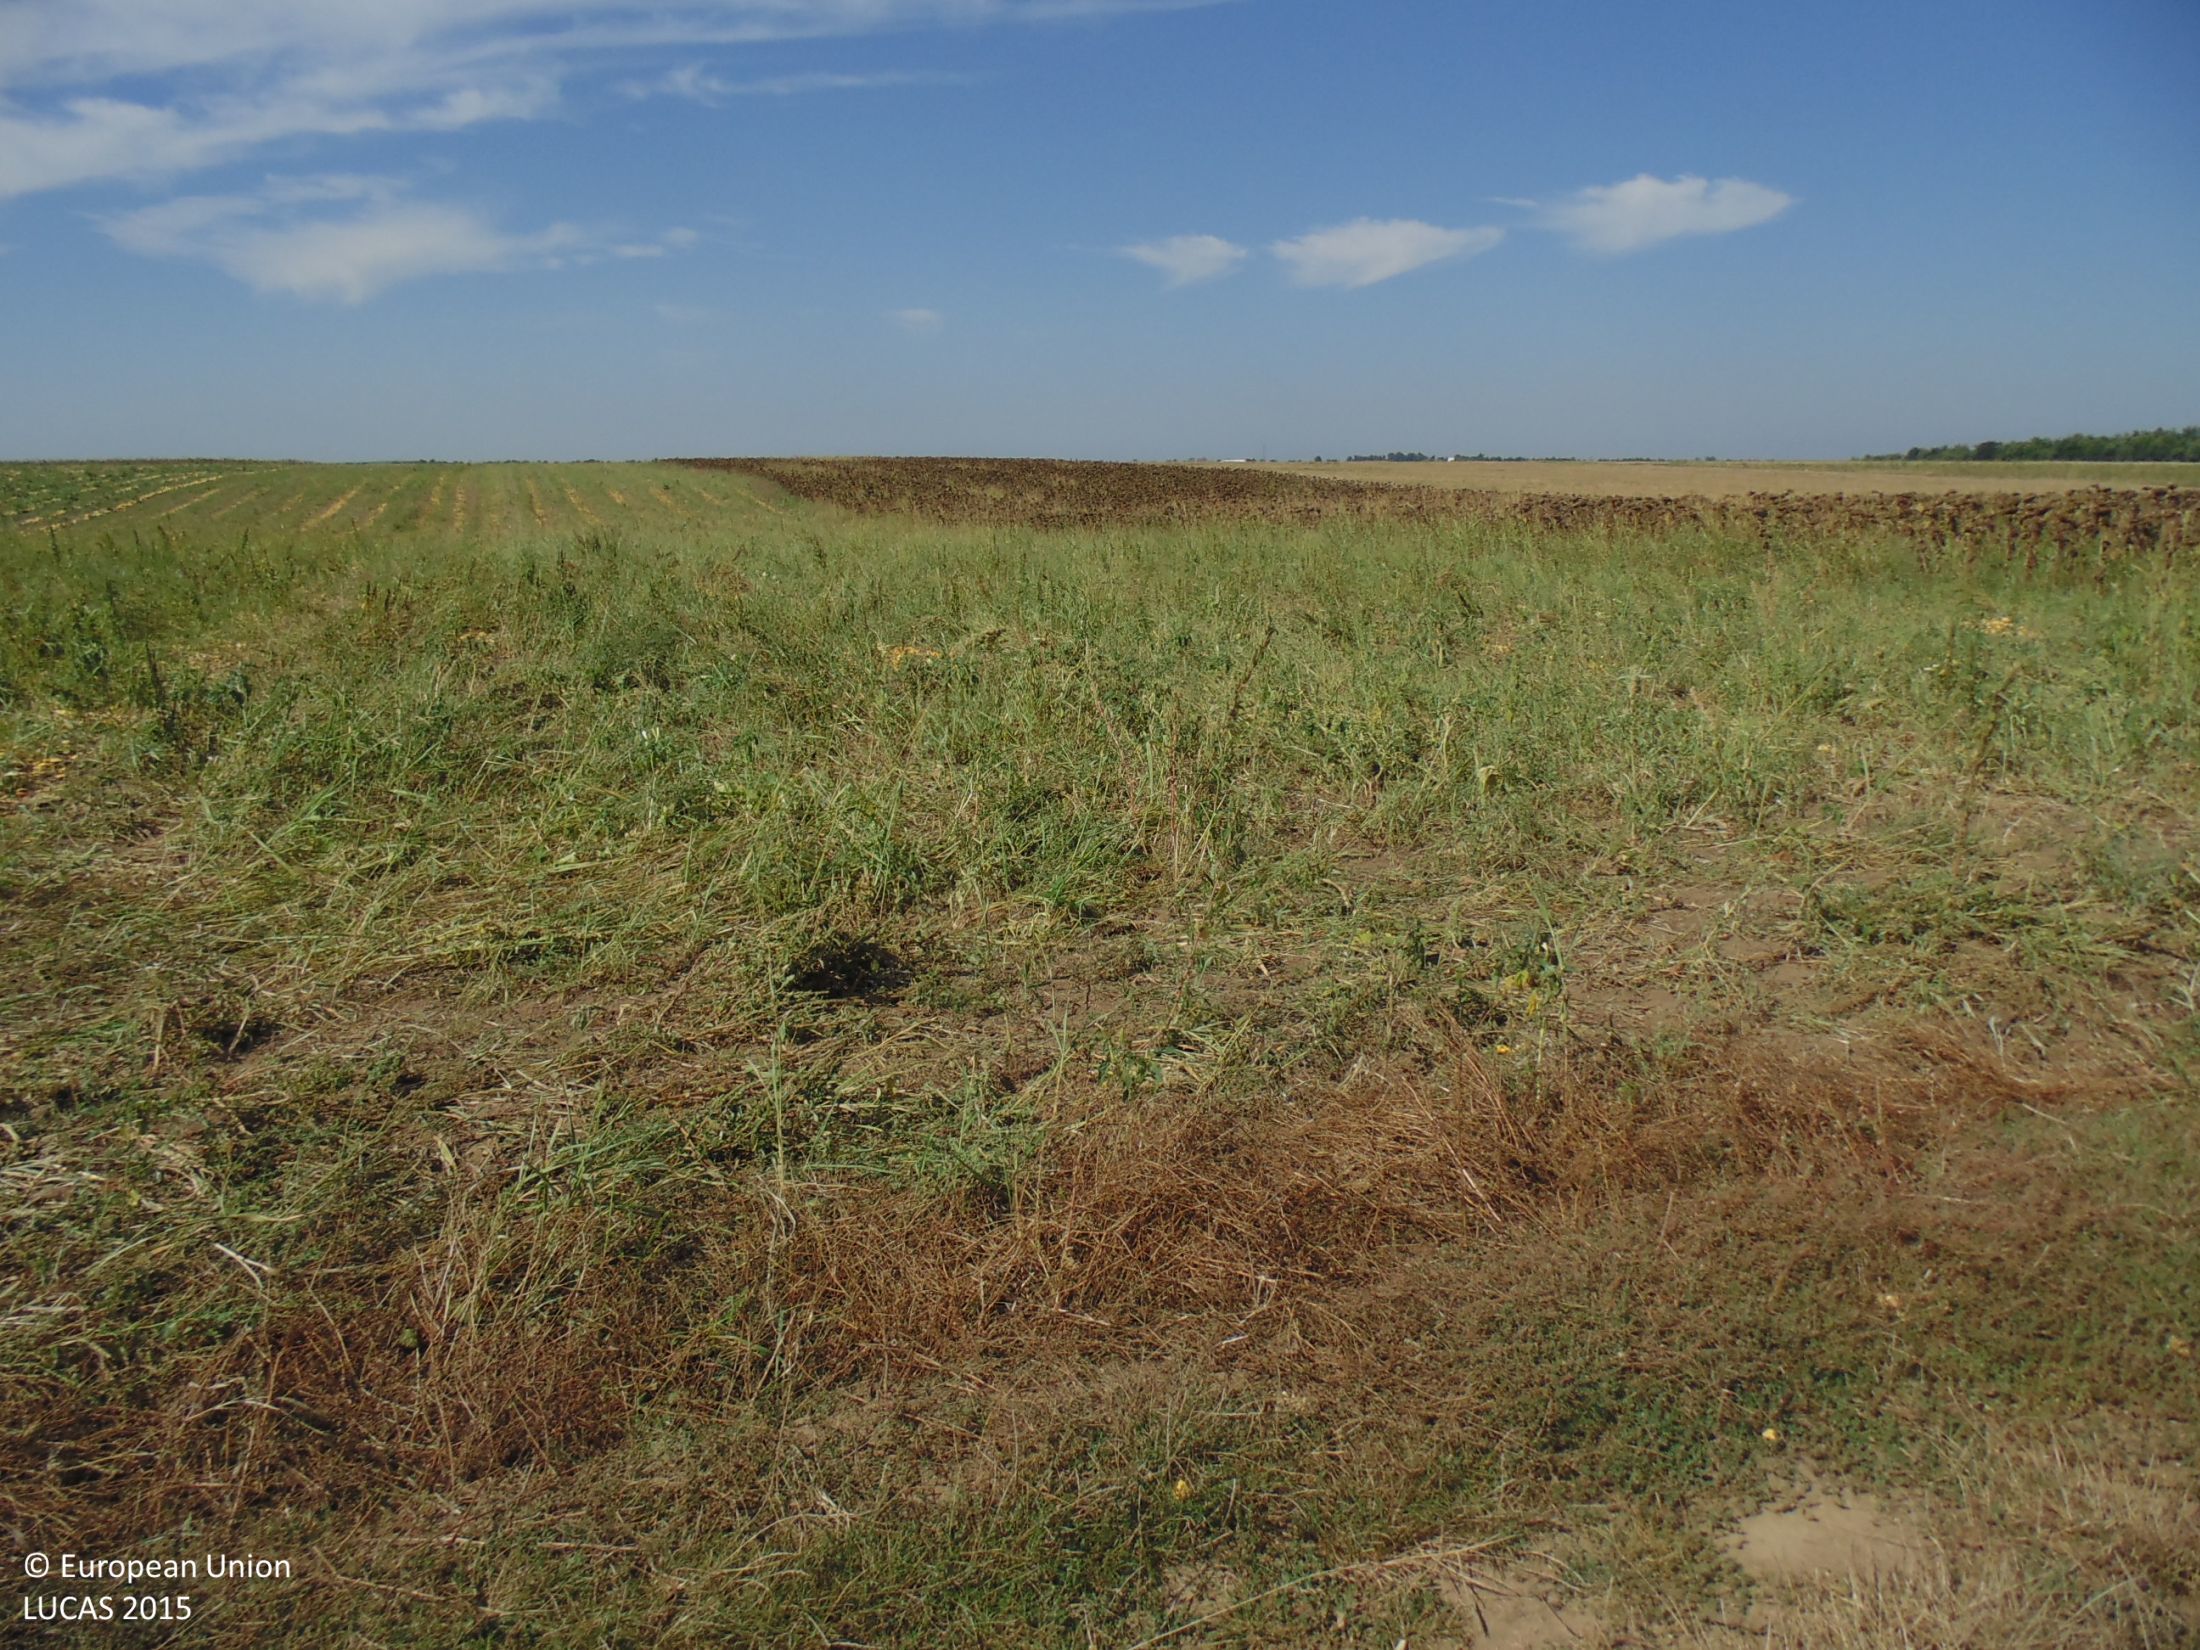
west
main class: Cropland
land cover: Sunflower
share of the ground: > 75 %
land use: Agriculture (excluding fallow land and kitchen gardens)
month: September
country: BG
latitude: 43.8909
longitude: 27.1168
